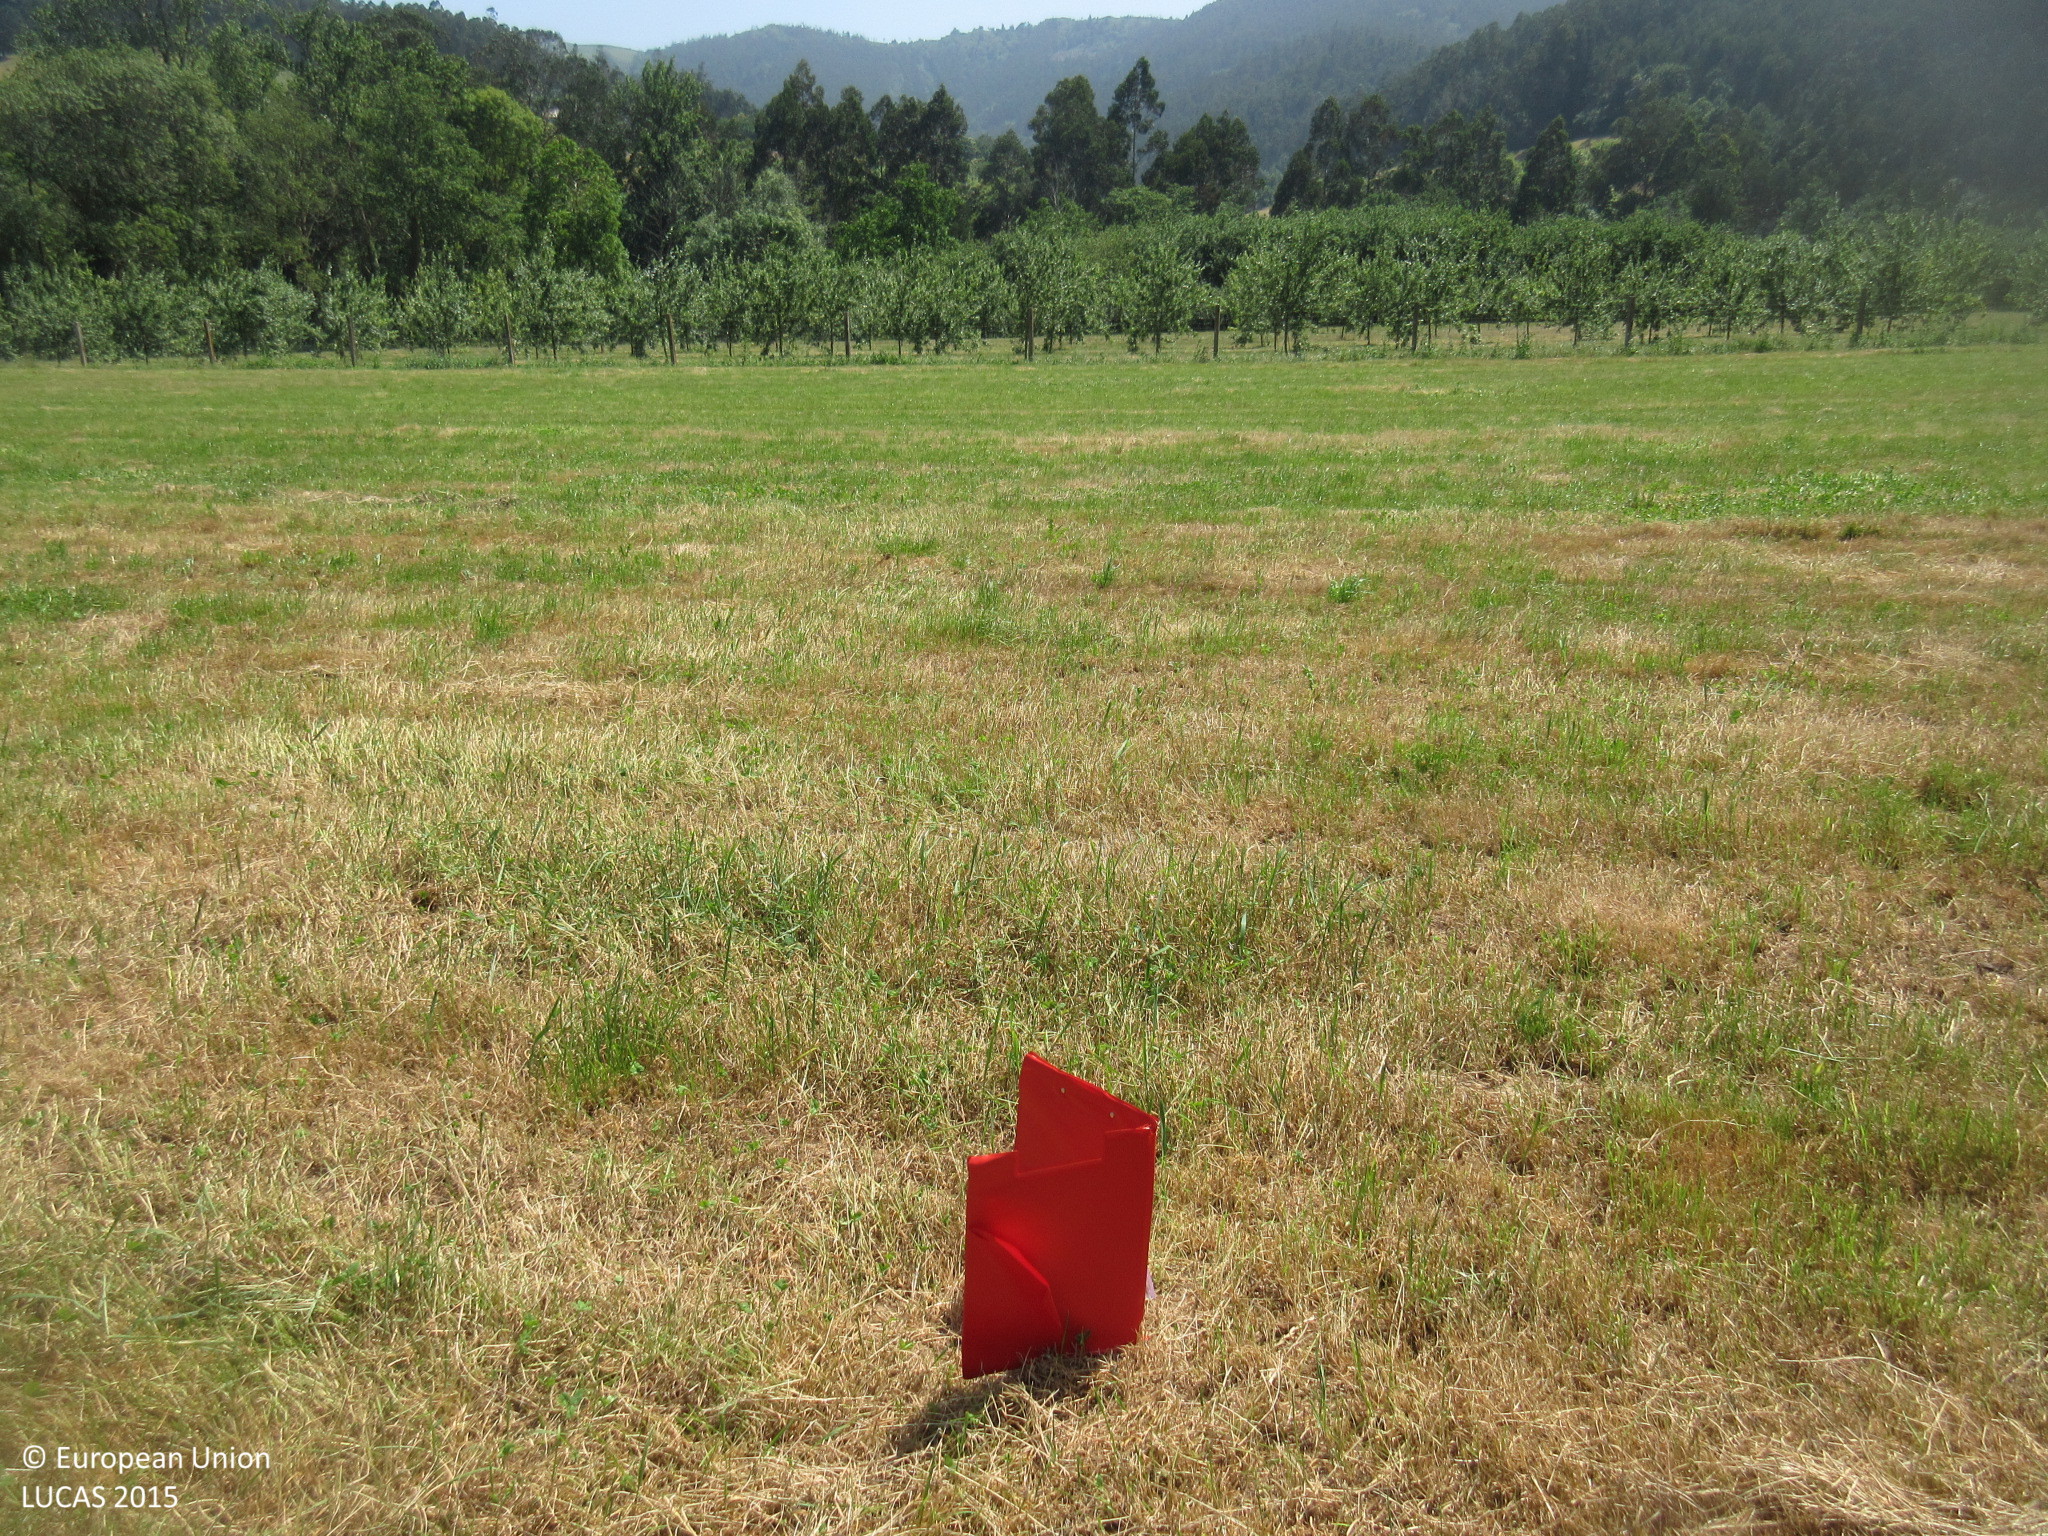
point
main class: Grassland
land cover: Grassland without tree/shrub cover
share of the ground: > 75 %
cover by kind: herbaceous plants 100 %
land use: Agriculture (excluding fallow land and kitchen gardens)
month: June
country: ES
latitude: 43.4069
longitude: -7.1488
